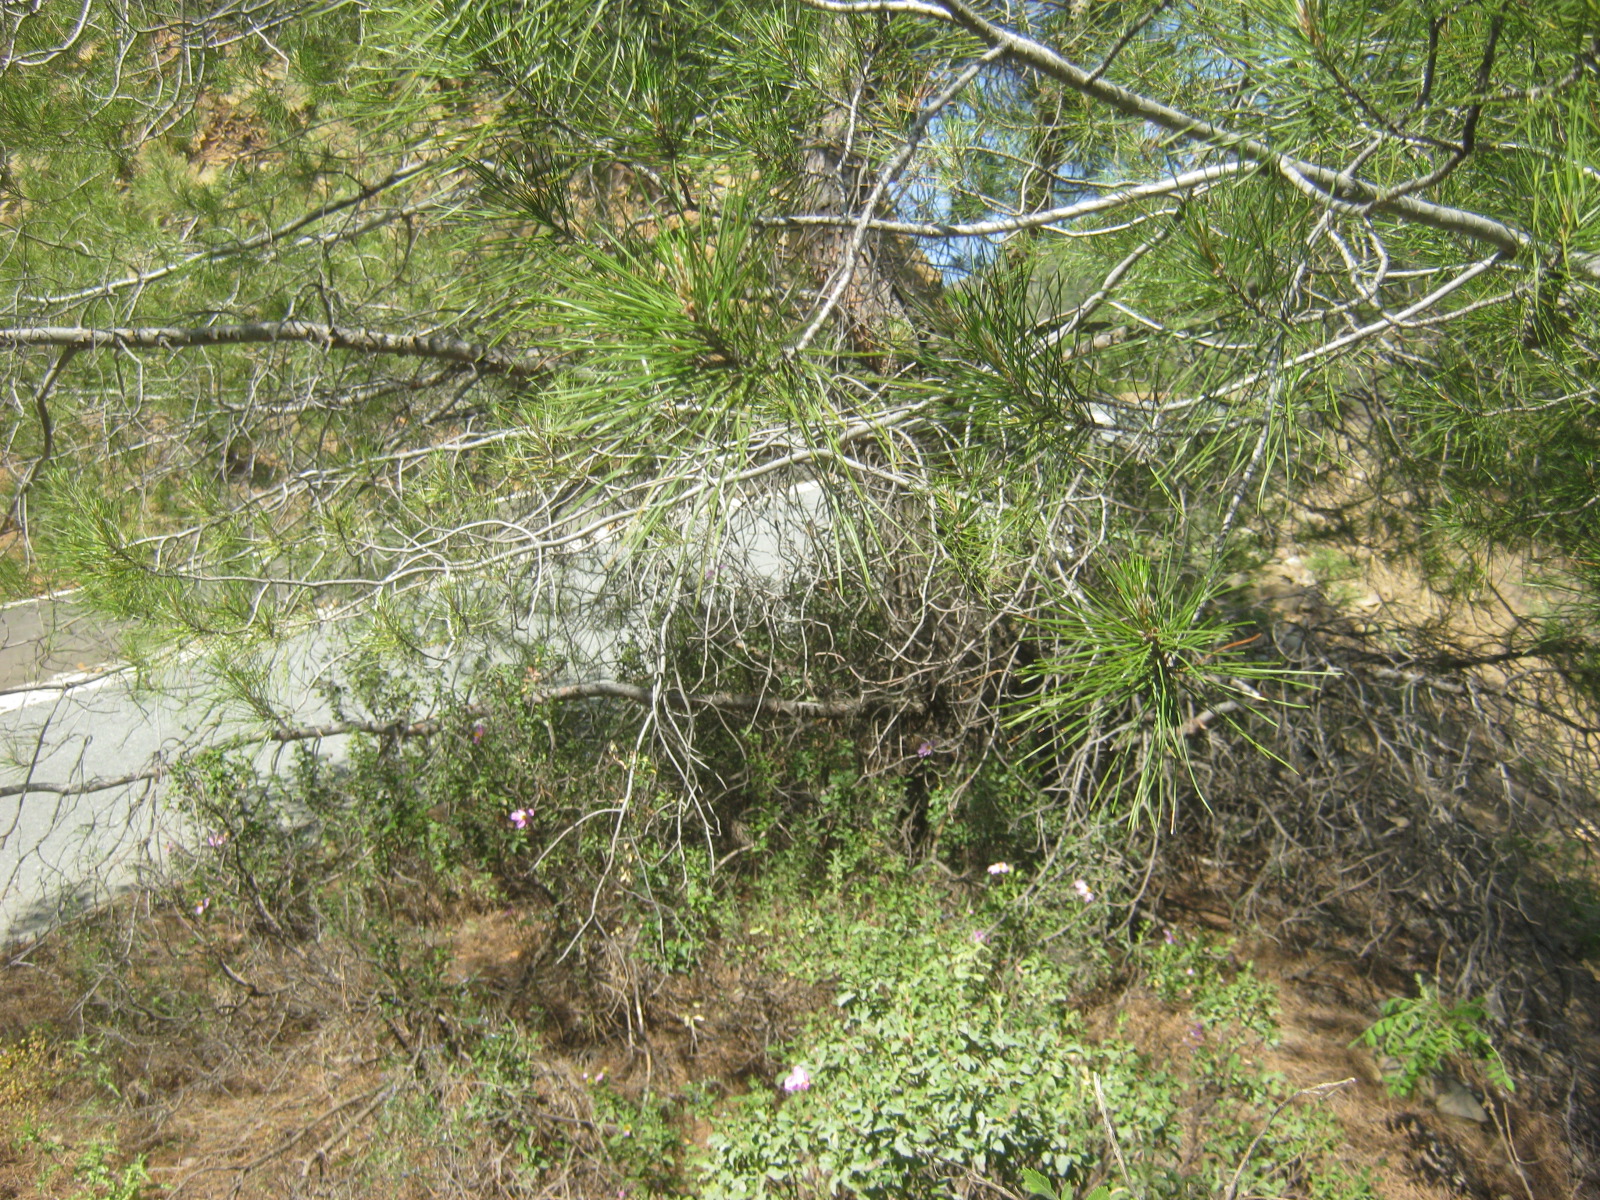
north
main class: Woodland
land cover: Pine dominated coniferous woodland
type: coniferous forest of the mediterranean region
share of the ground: 50 - 75 %
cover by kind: coniferous forest trees 50 %, unconsolidated bare surface 20 %, herbaceous plants 15 %, shrubs 10 %, broadleaved forest trees 5 %
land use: Semi-natural and natural areas not in use
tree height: > 5 m
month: May
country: CY
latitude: 34.9572
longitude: 32.8006
